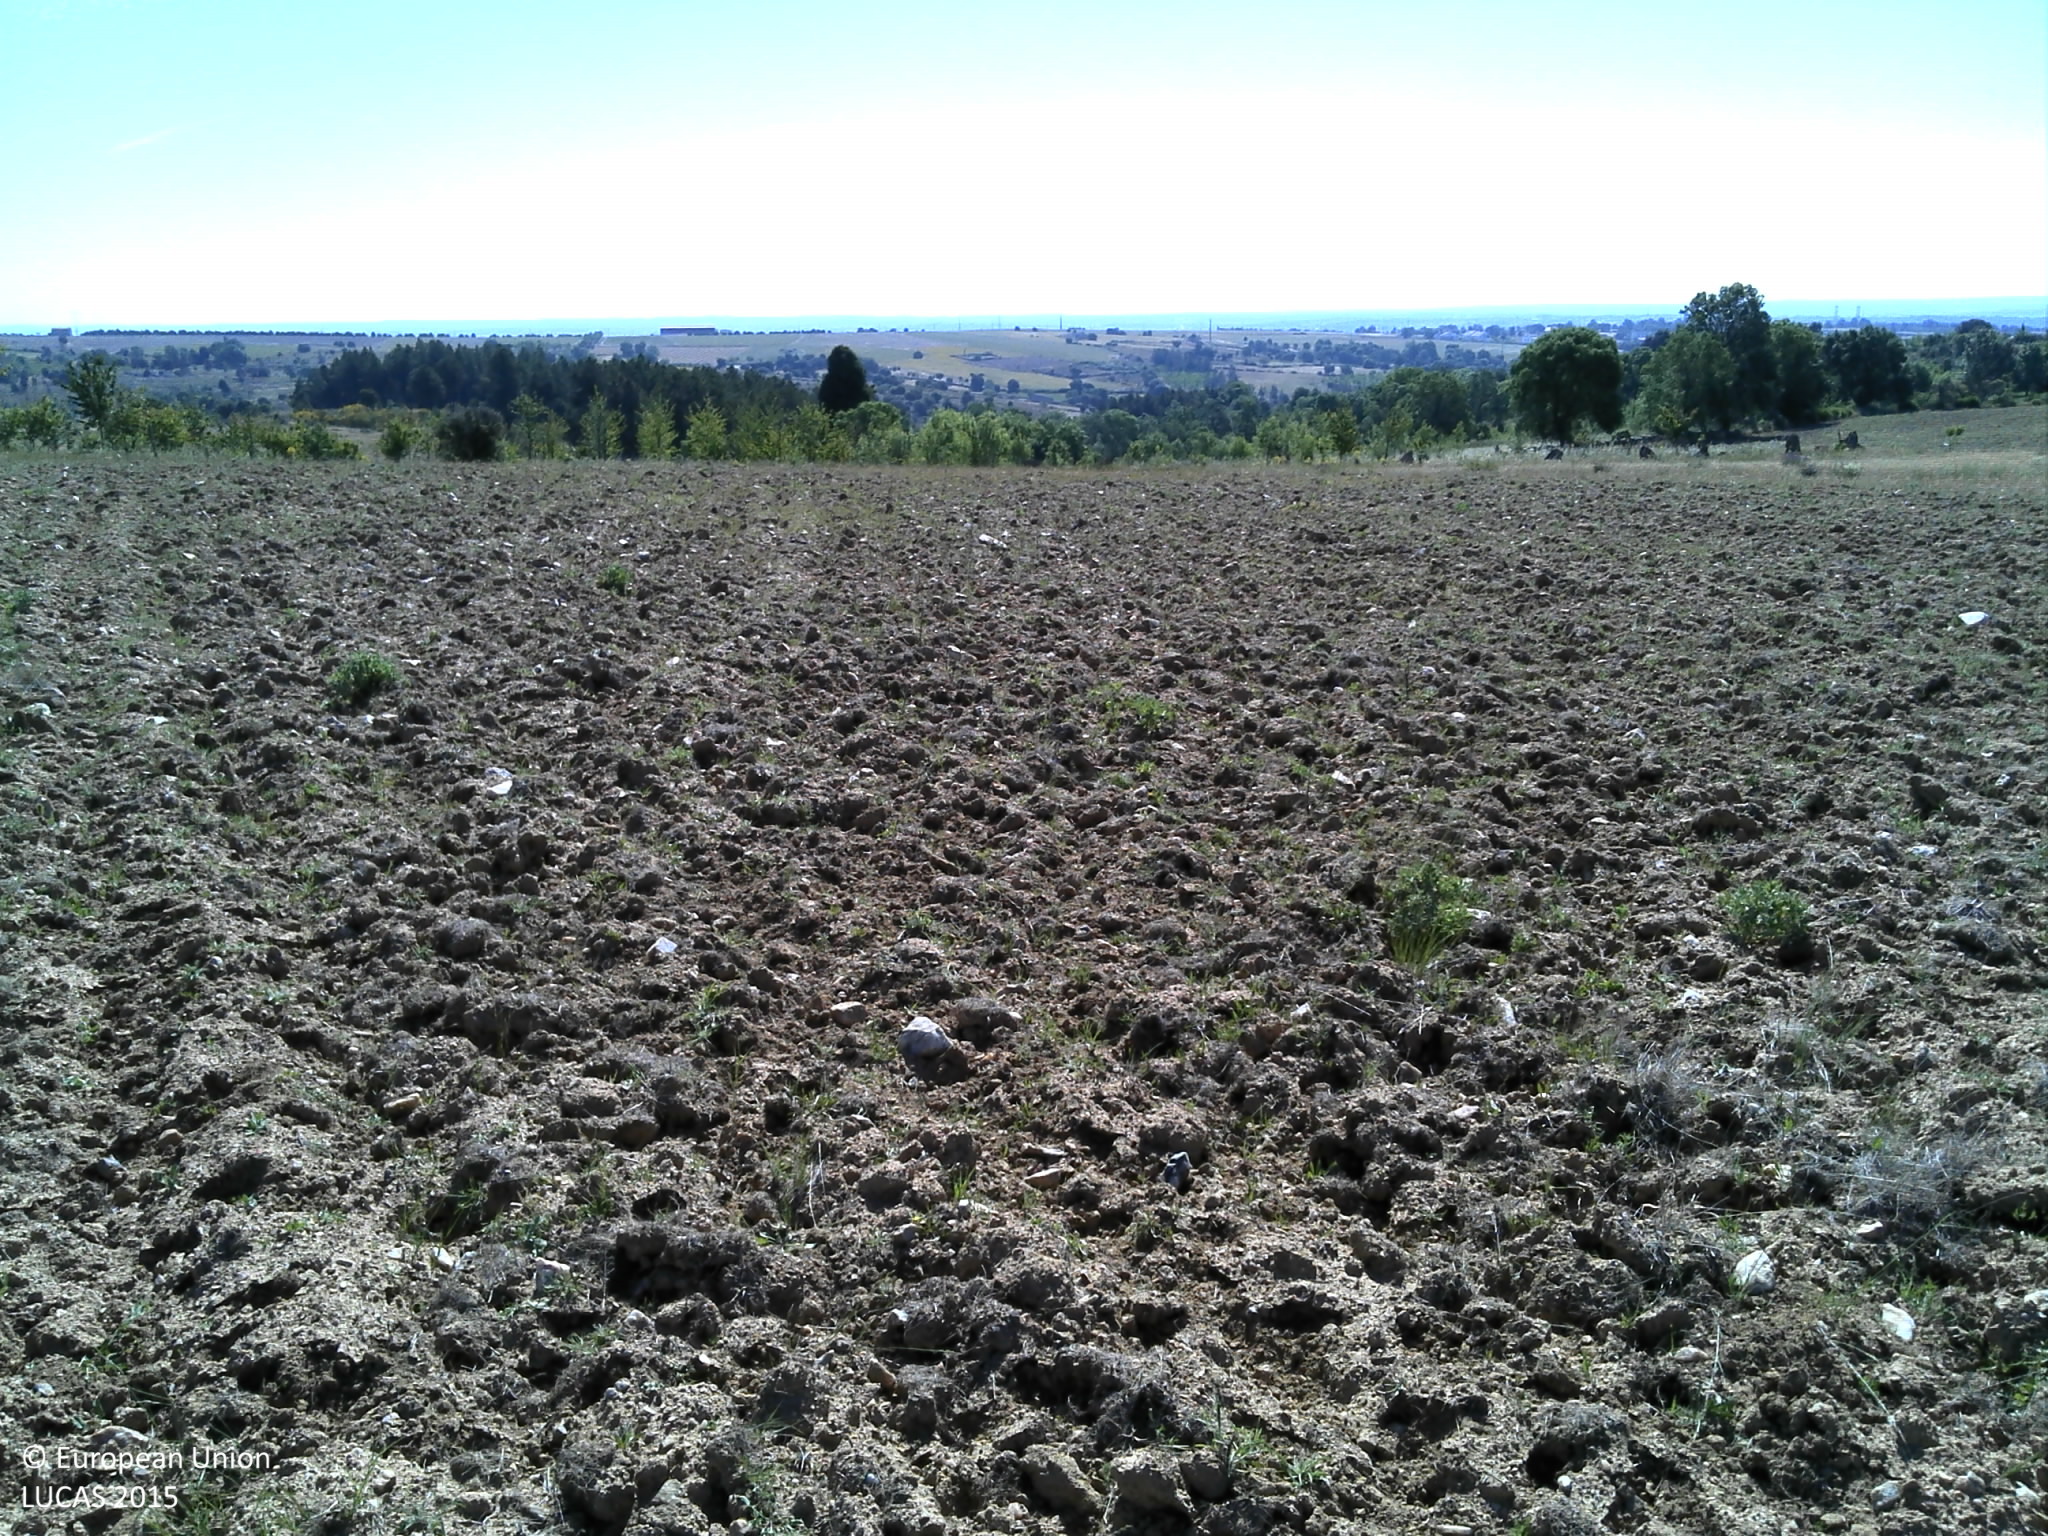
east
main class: Grassland
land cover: Spontaneously vegetated surfaces
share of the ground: < 10 %
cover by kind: unconsolidated bare surface 80 %, herbaceous plants 20 %
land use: Fallow land
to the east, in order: Spontaneously vegetated surfaces; Nuts trees; Grass margins; Fences; Broadleaved woodland
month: May
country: PT
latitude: 41.4843
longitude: -6.3268
